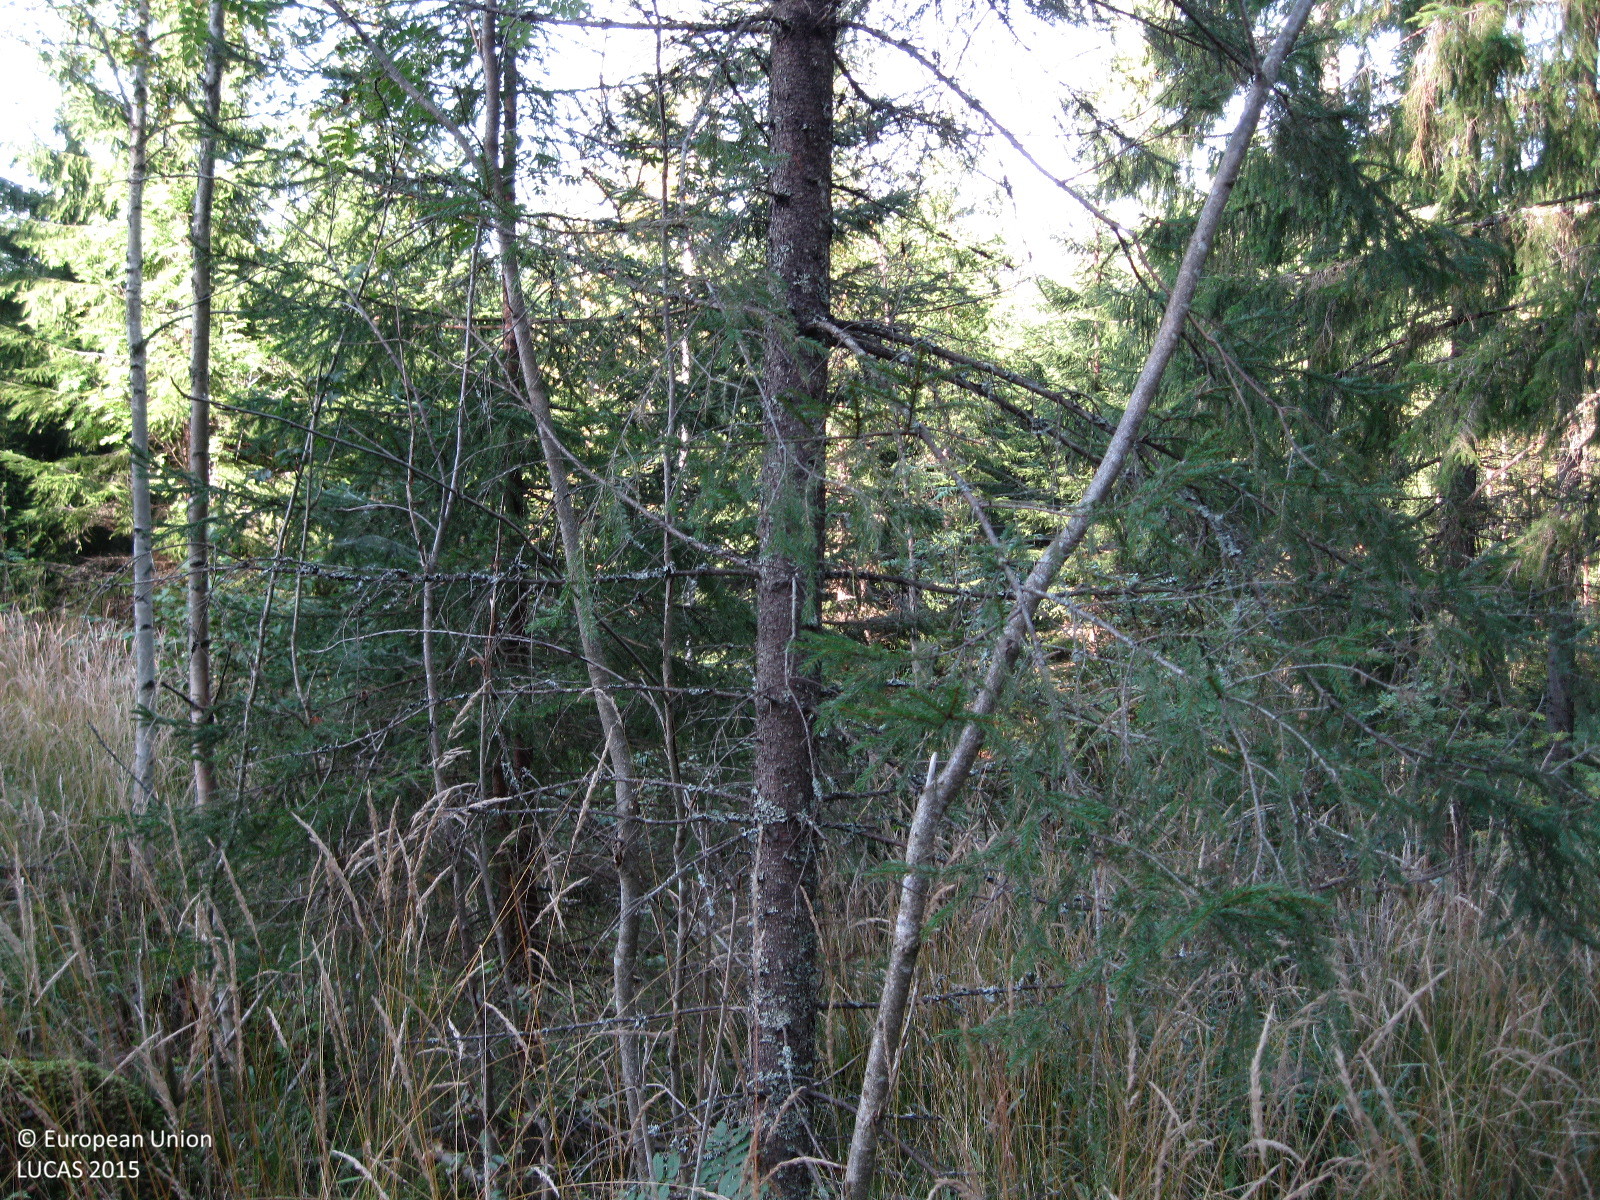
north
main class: Woodland
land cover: Pine dominated coniferous woodland
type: boreal forest
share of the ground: > 75 %
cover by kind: coniferous forest trees 70 %, herbaceous plants 25 %, broadleaved forest trees 5 %
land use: Forestry
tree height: > 5 m
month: September
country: FI
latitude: 60.5352
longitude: 24.5973
